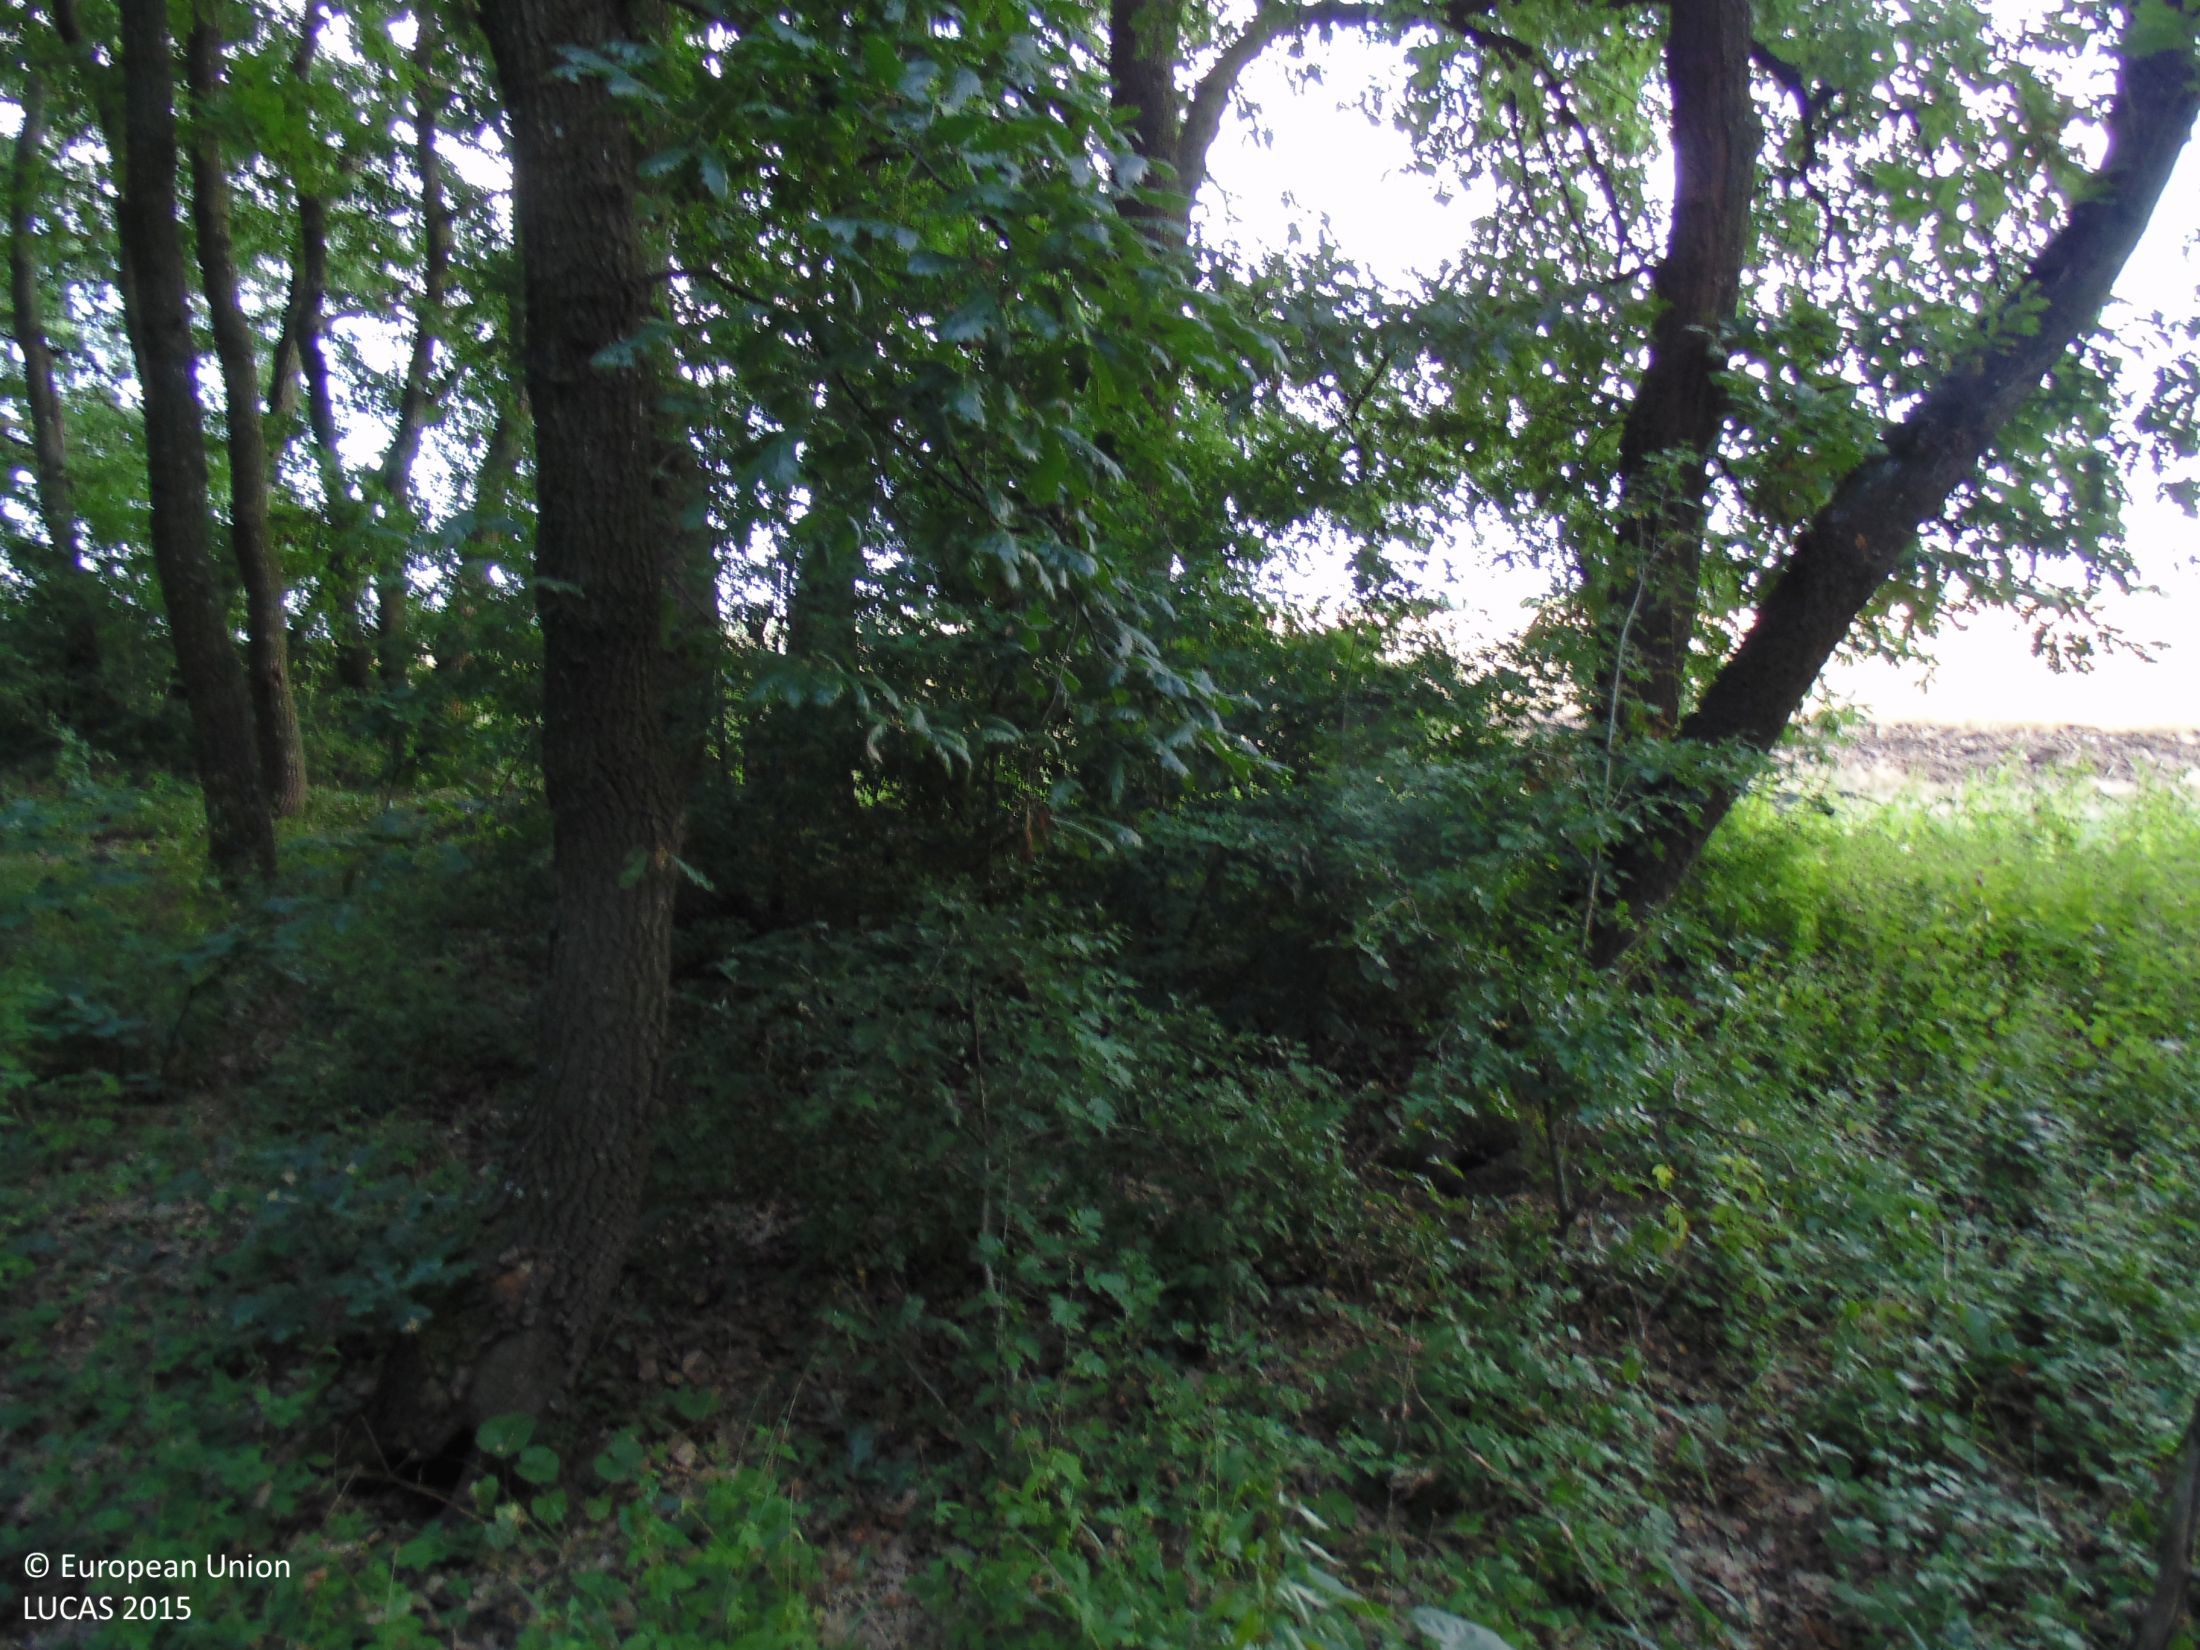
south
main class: Woodland
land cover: Broadleaved woodland
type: mesophytic deciduous forest
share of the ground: > 75 %
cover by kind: broadleaved forest trees 90 %, shrubs 5 %, herbaceous plants 5 %
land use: Forestry
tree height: > 5 m
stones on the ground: < 10 %
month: July
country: BG
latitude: 43.5203
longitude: 27.6666
